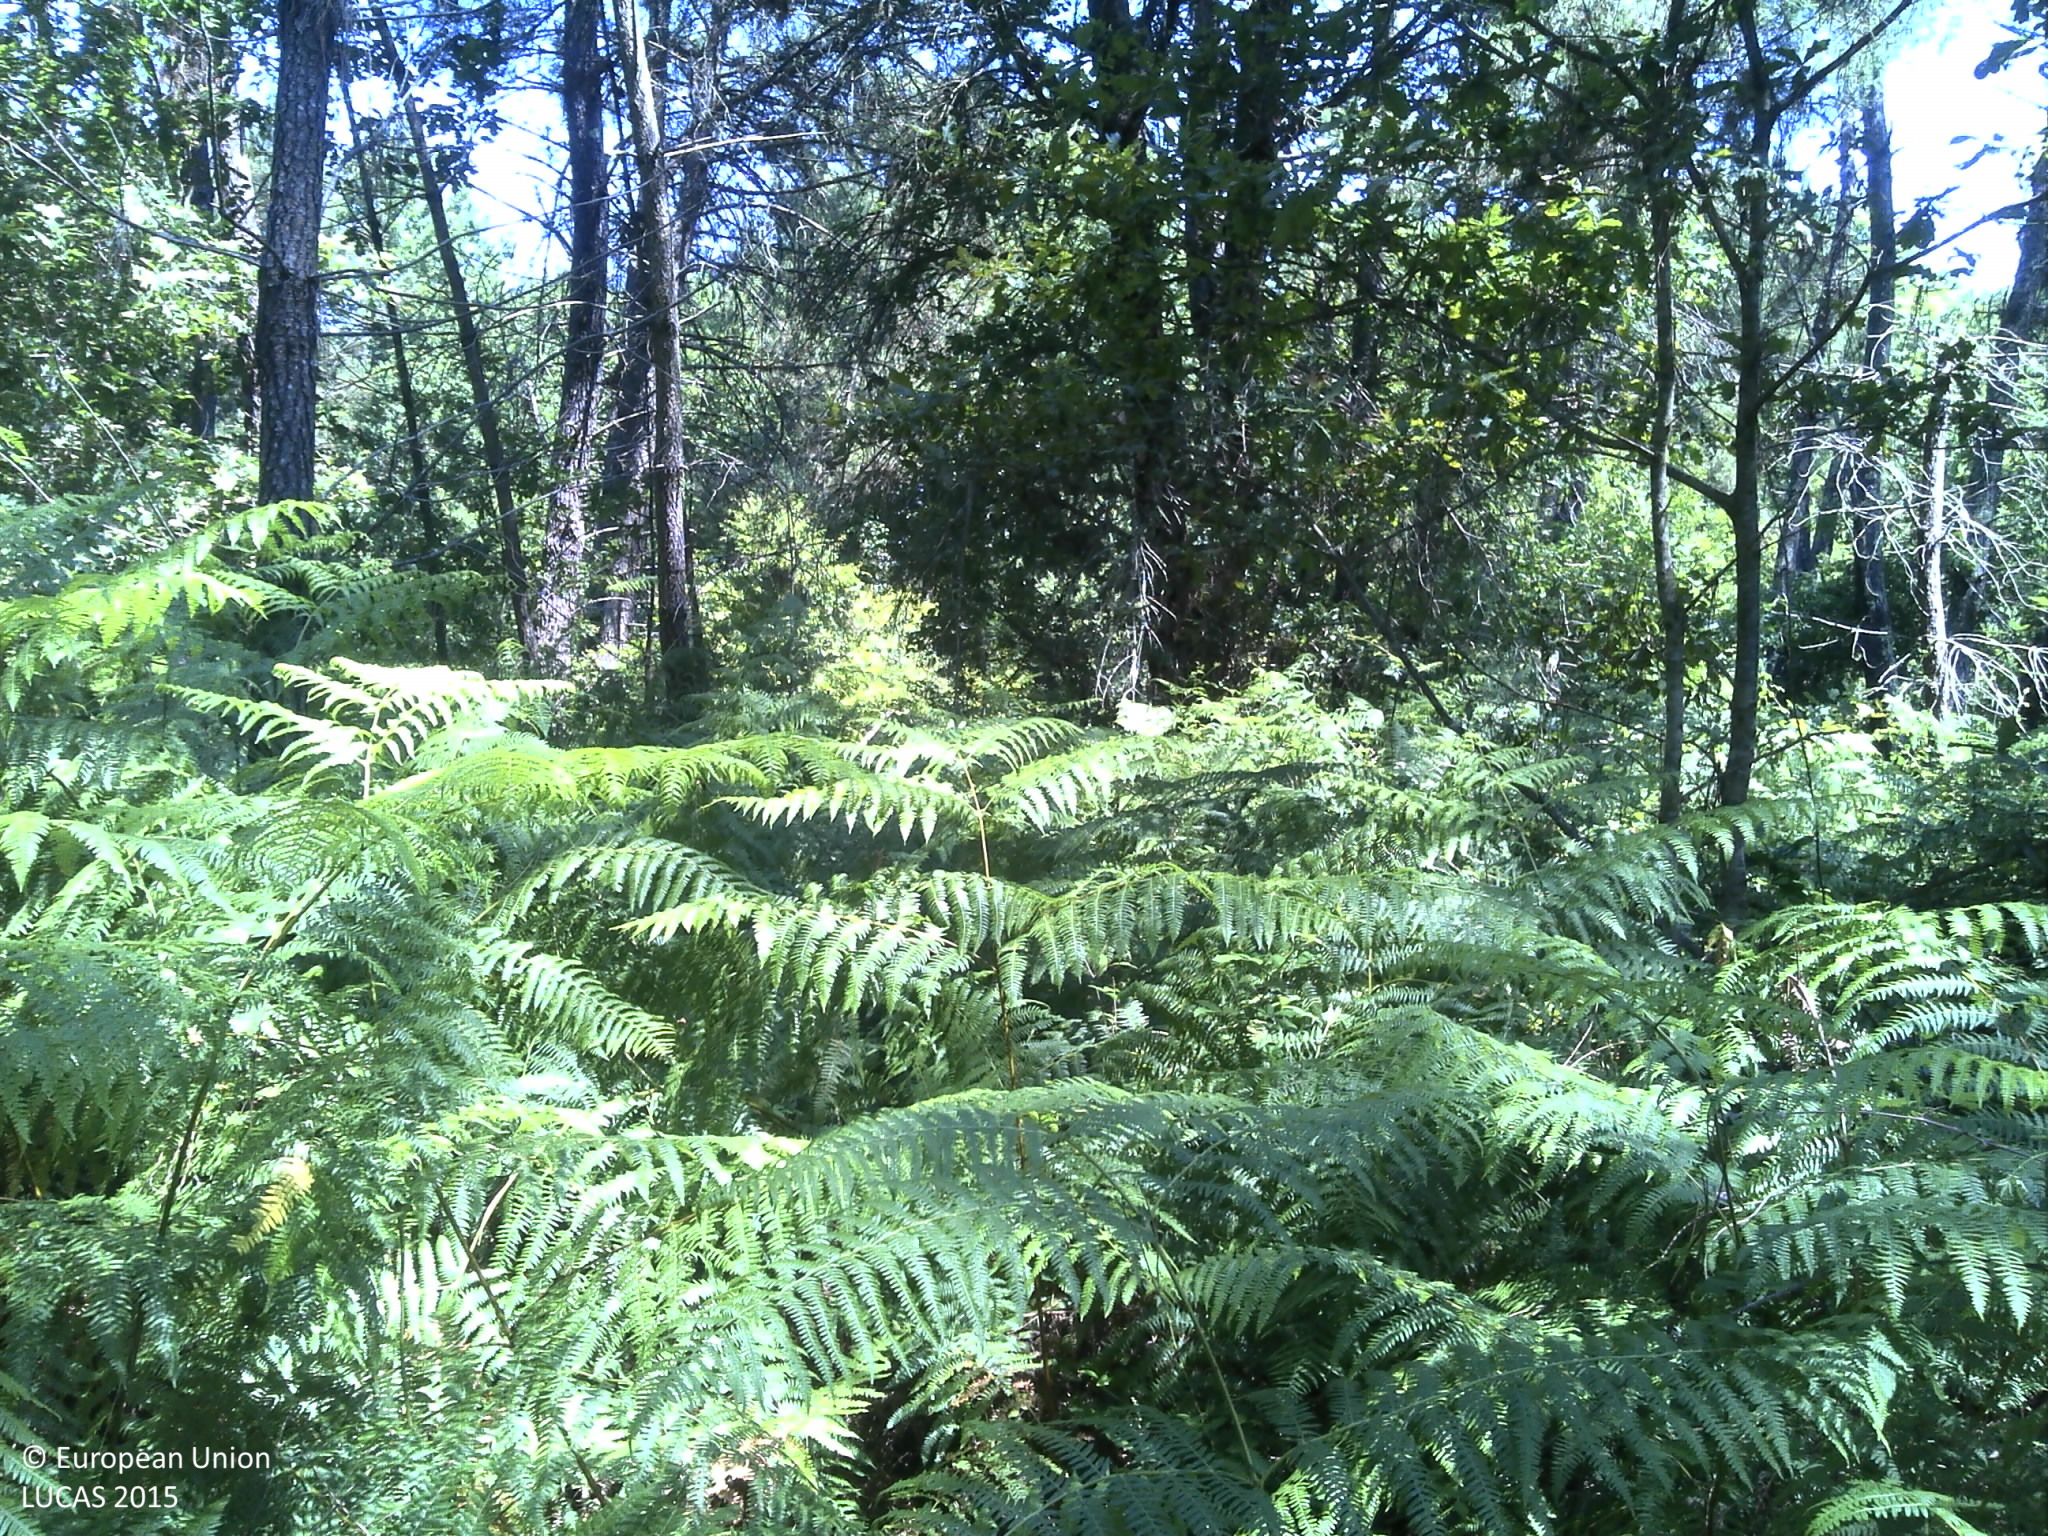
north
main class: Woodland
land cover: Pine dominated coniferous woodland
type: coniferous forest of the mediterranean region
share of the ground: 50 - 75 %
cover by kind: coniferous forest trees 60 %, shrubs 25 %, unconsolidated bare surface 10 %, herbaceous plants 5 %
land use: Forestry
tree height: > 5 m
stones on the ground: < 10 %
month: June
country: PT
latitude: 40.5606
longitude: -8.0183
